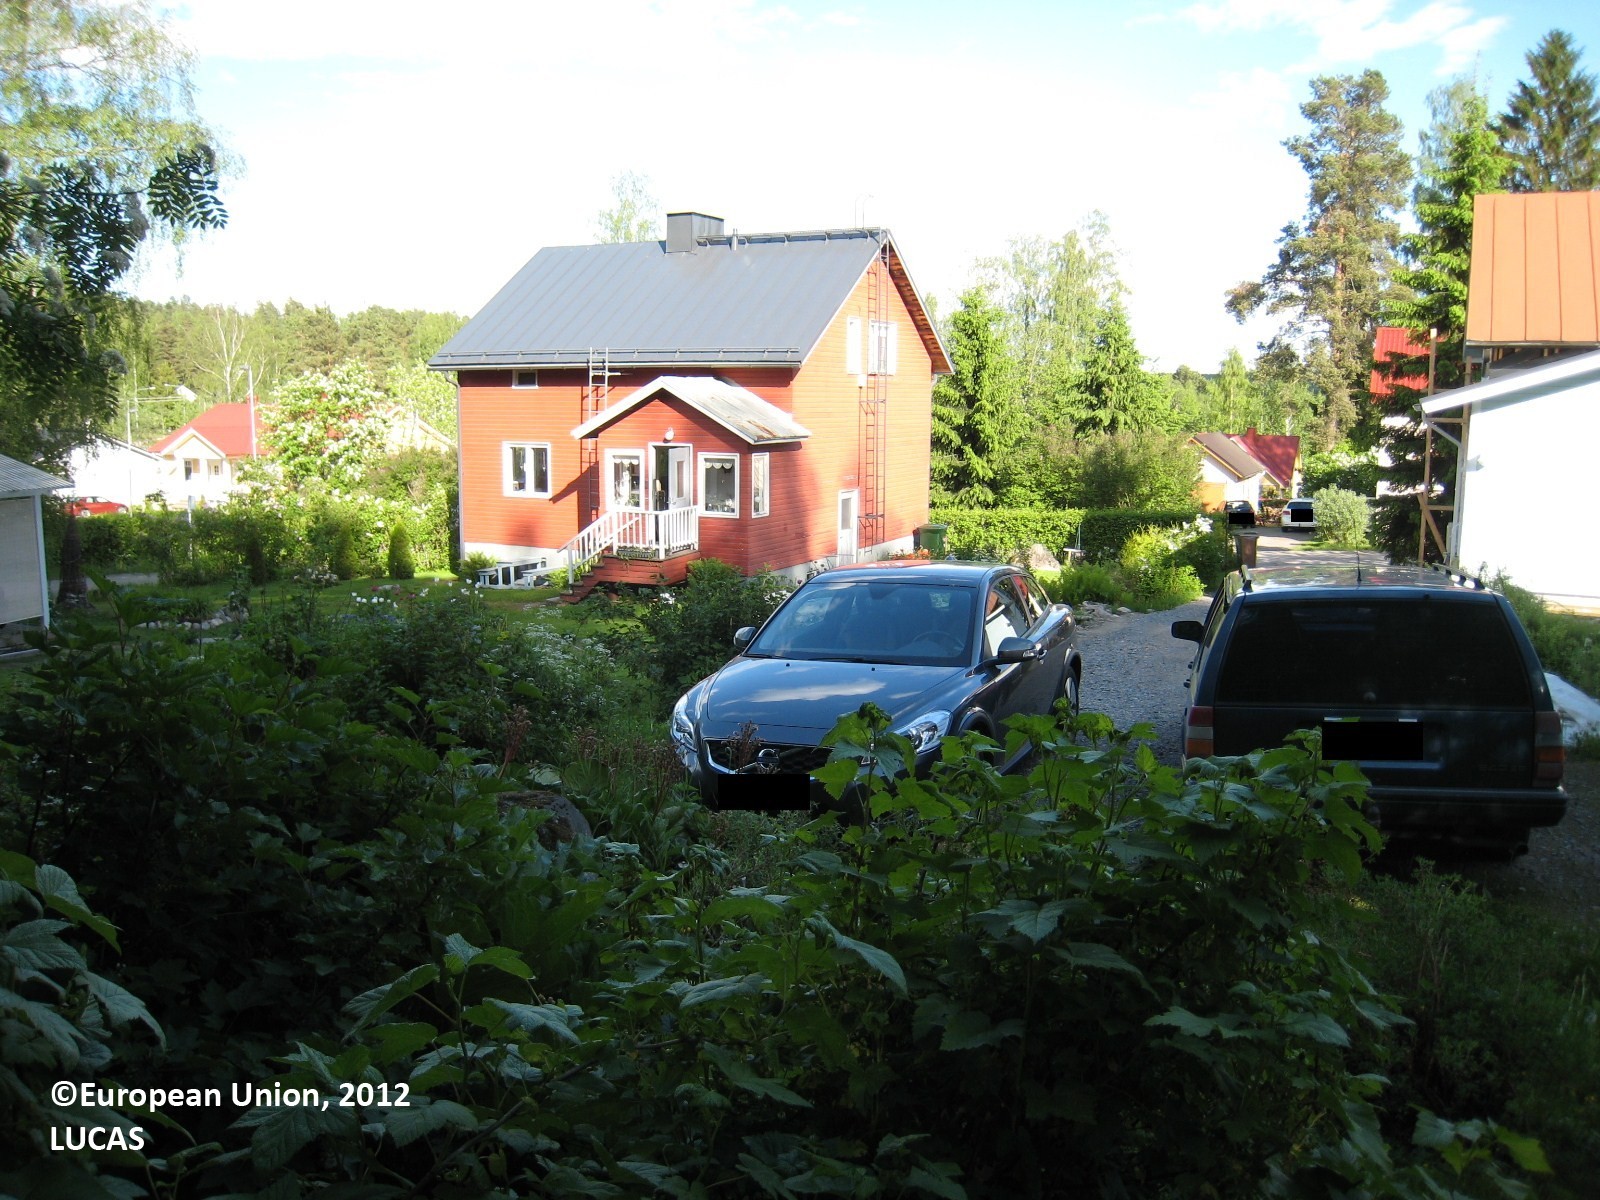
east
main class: Grassland
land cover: Grassland with sparse tree/shrub cover
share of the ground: > 75 %
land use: Residential
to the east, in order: Grassland with sparse tree/shrub cover; Artificial constructions in urban areas
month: June
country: FI
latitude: 62.2448
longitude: 25.8487
